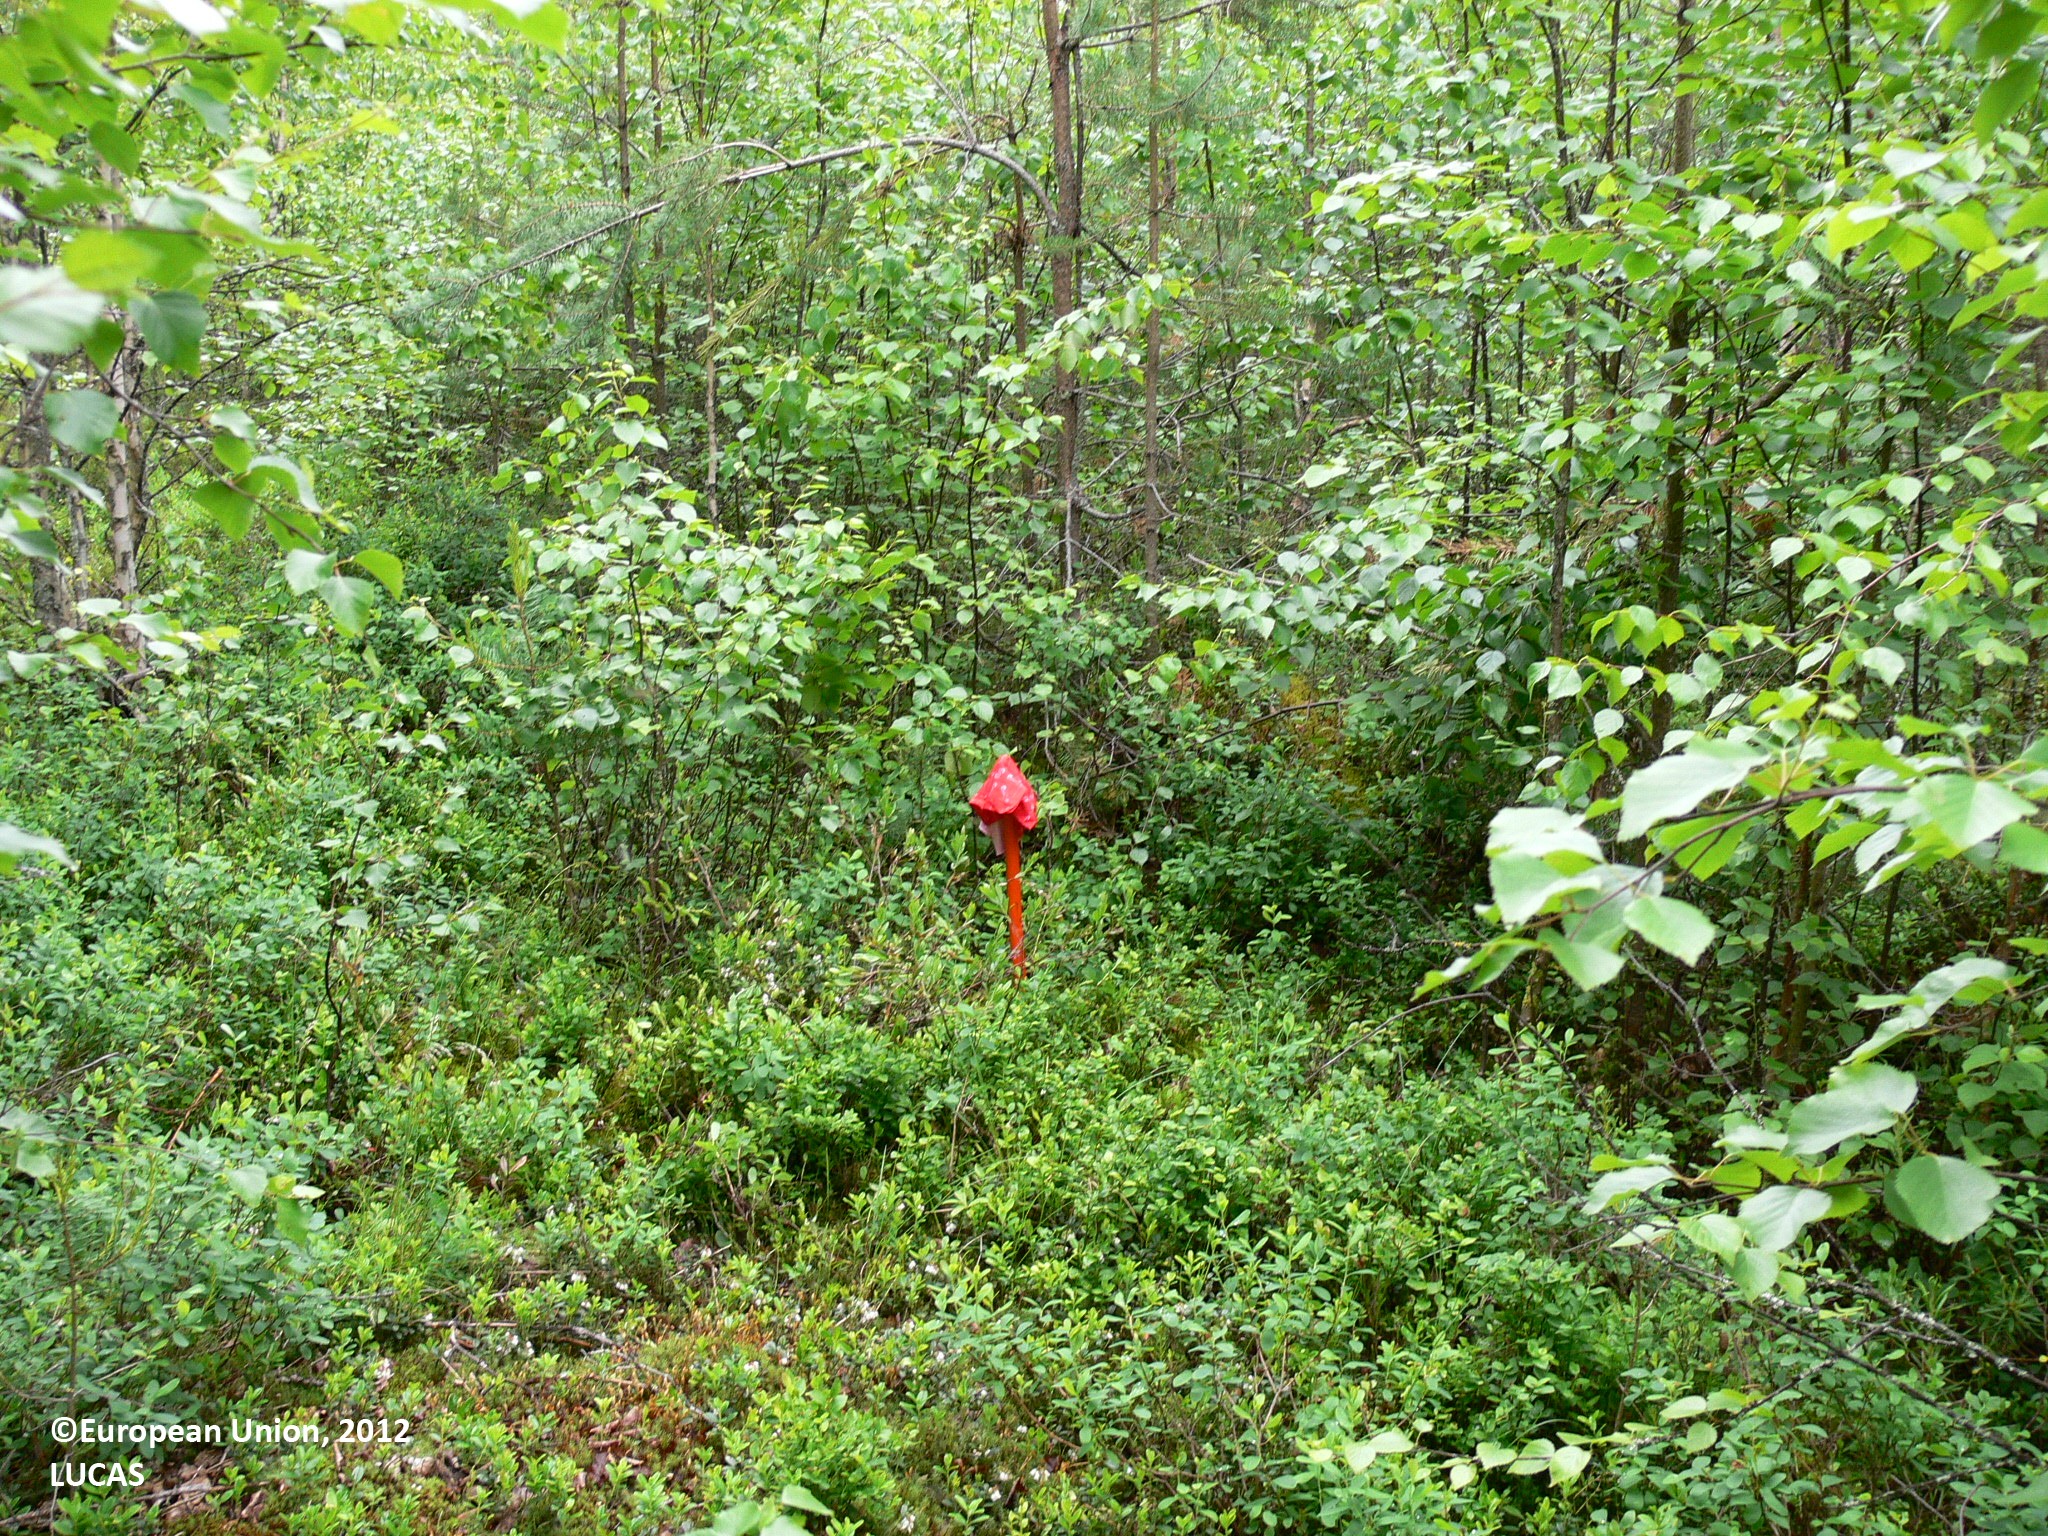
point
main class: Woodland
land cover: Pine dominated mixed woodland
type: boreal forest
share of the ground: 50 - 75 %
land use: Forestry
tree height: > 5 m
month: June
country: FI
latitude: 62.9323
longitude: 29.4374
